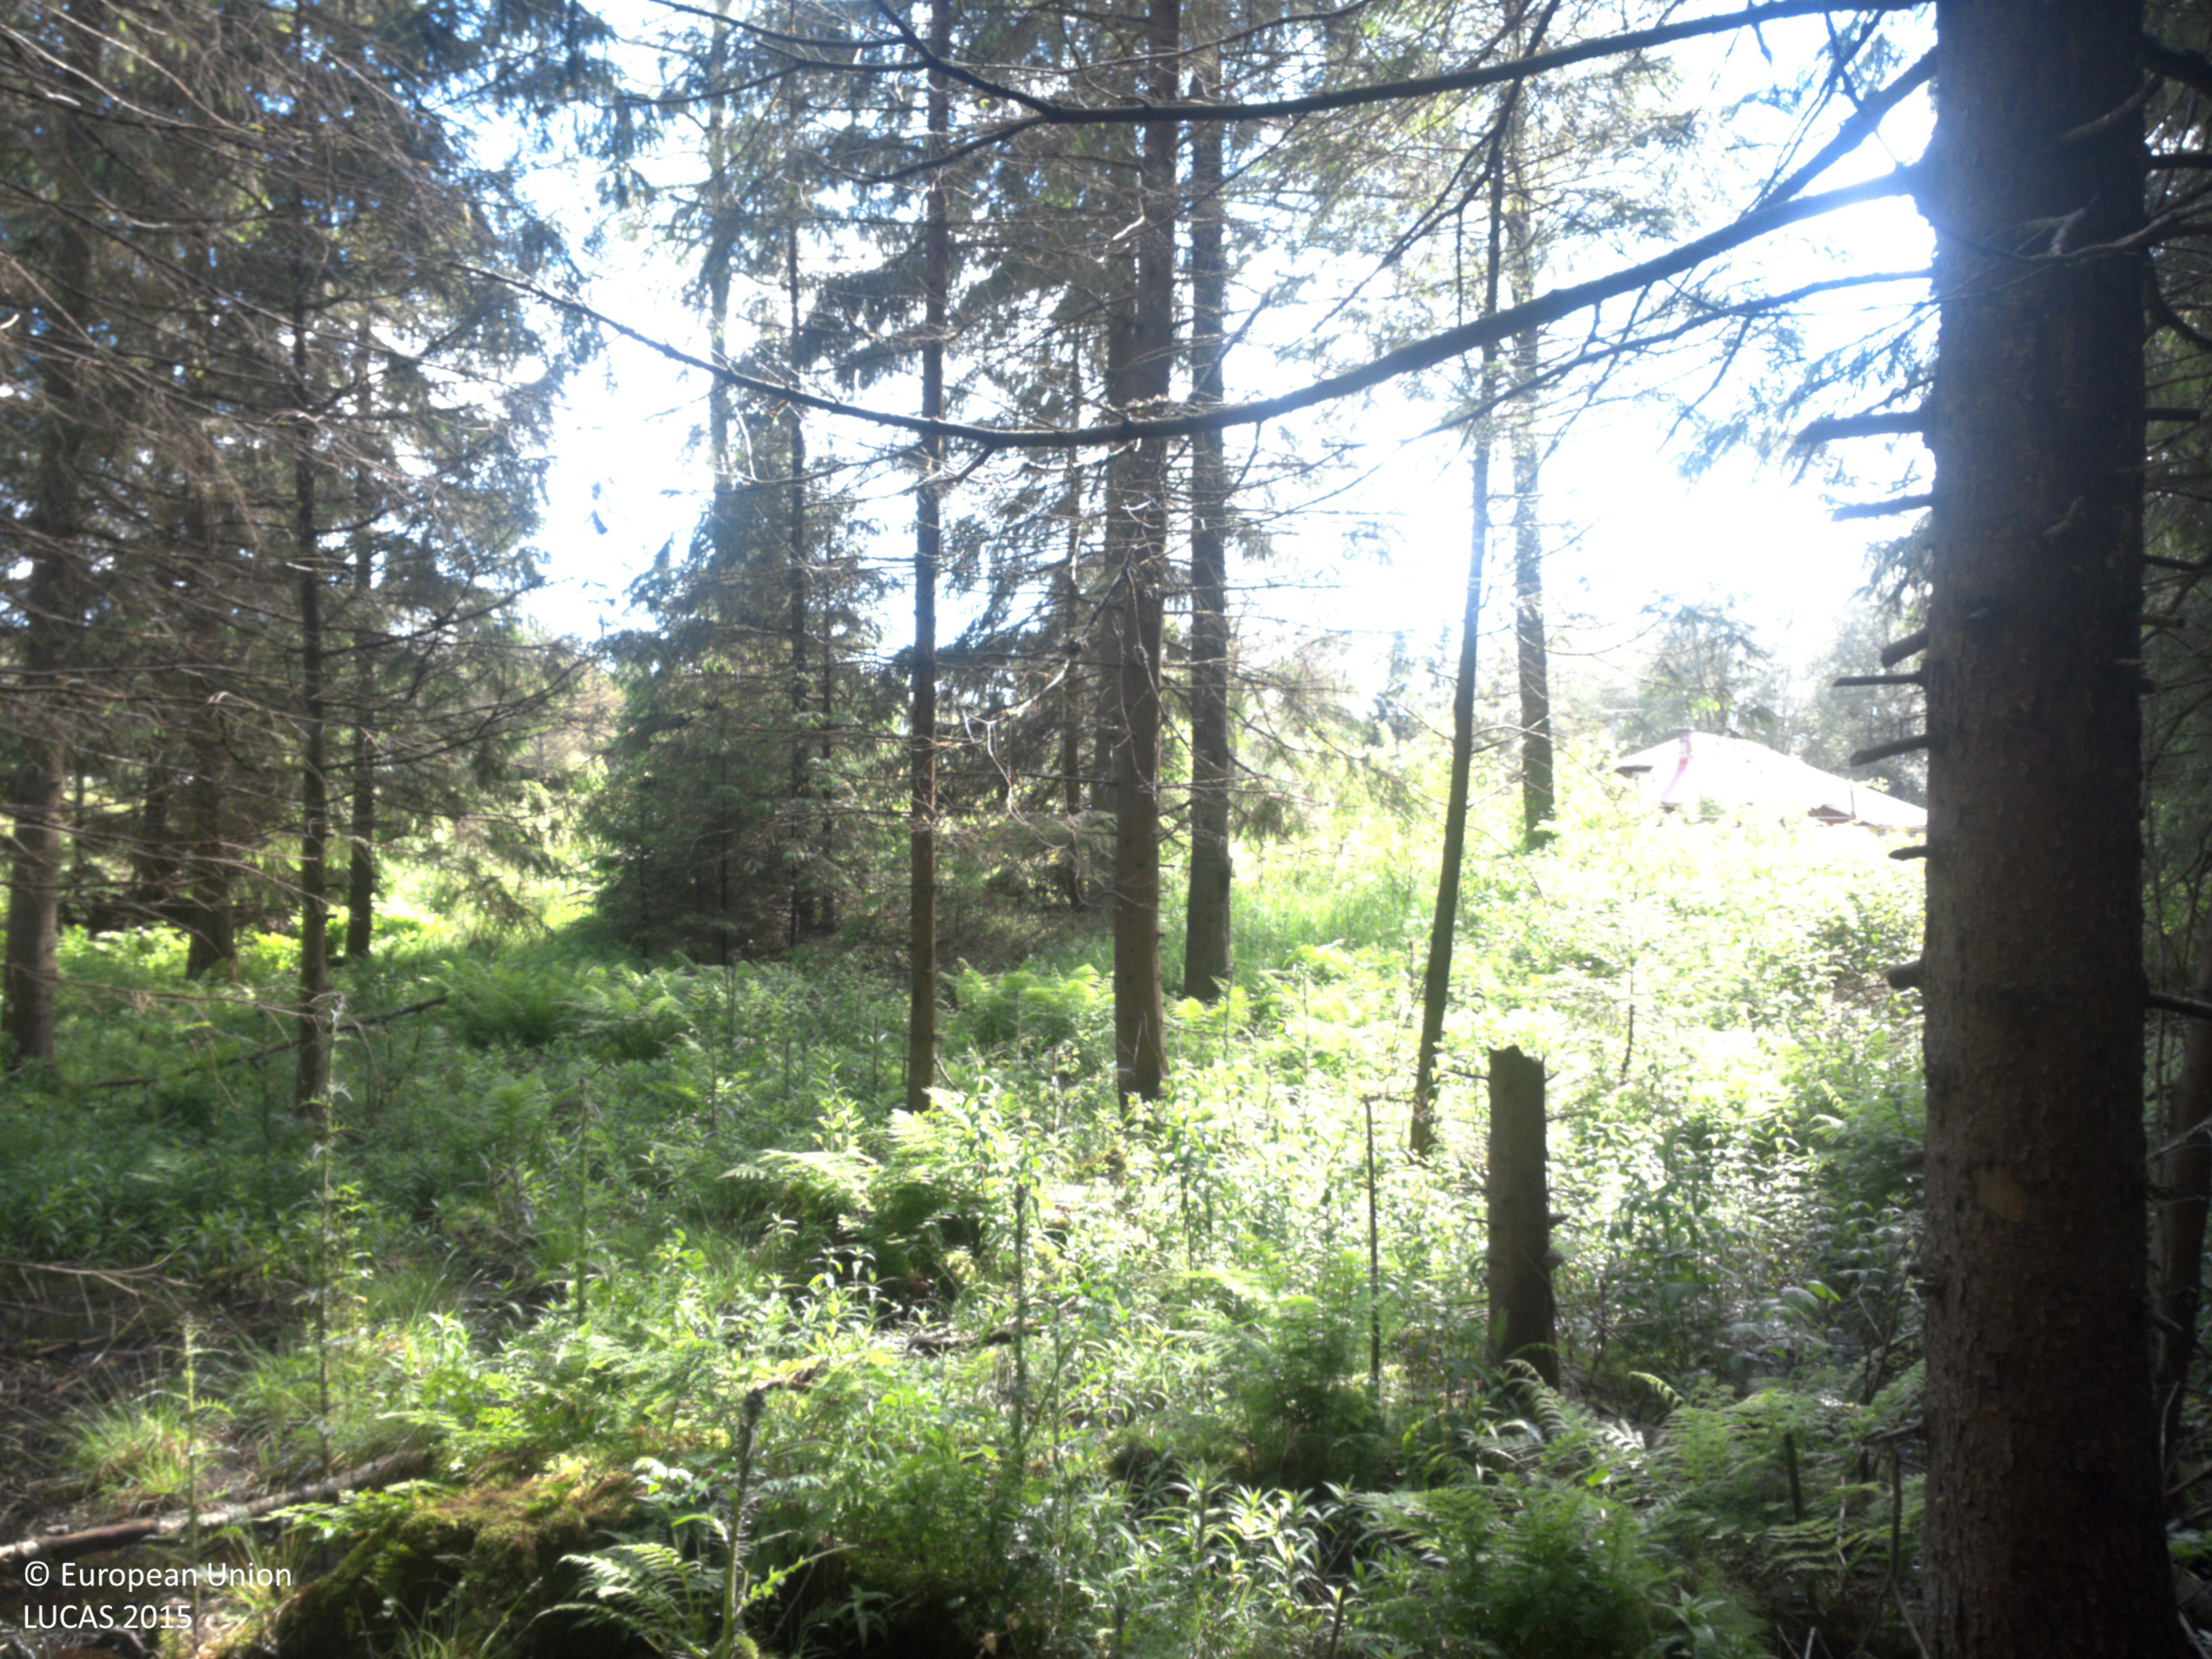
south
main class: Woodland
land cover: Spruce dominated coniferous woodland
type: boreal forest
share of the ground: > 75 %
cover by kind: coniferous forest trees 90 %, lichens and mosses 10 %
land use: Forestry
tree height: > 5 m
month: June
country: SE
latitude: 58.7676
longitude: 11.6044
